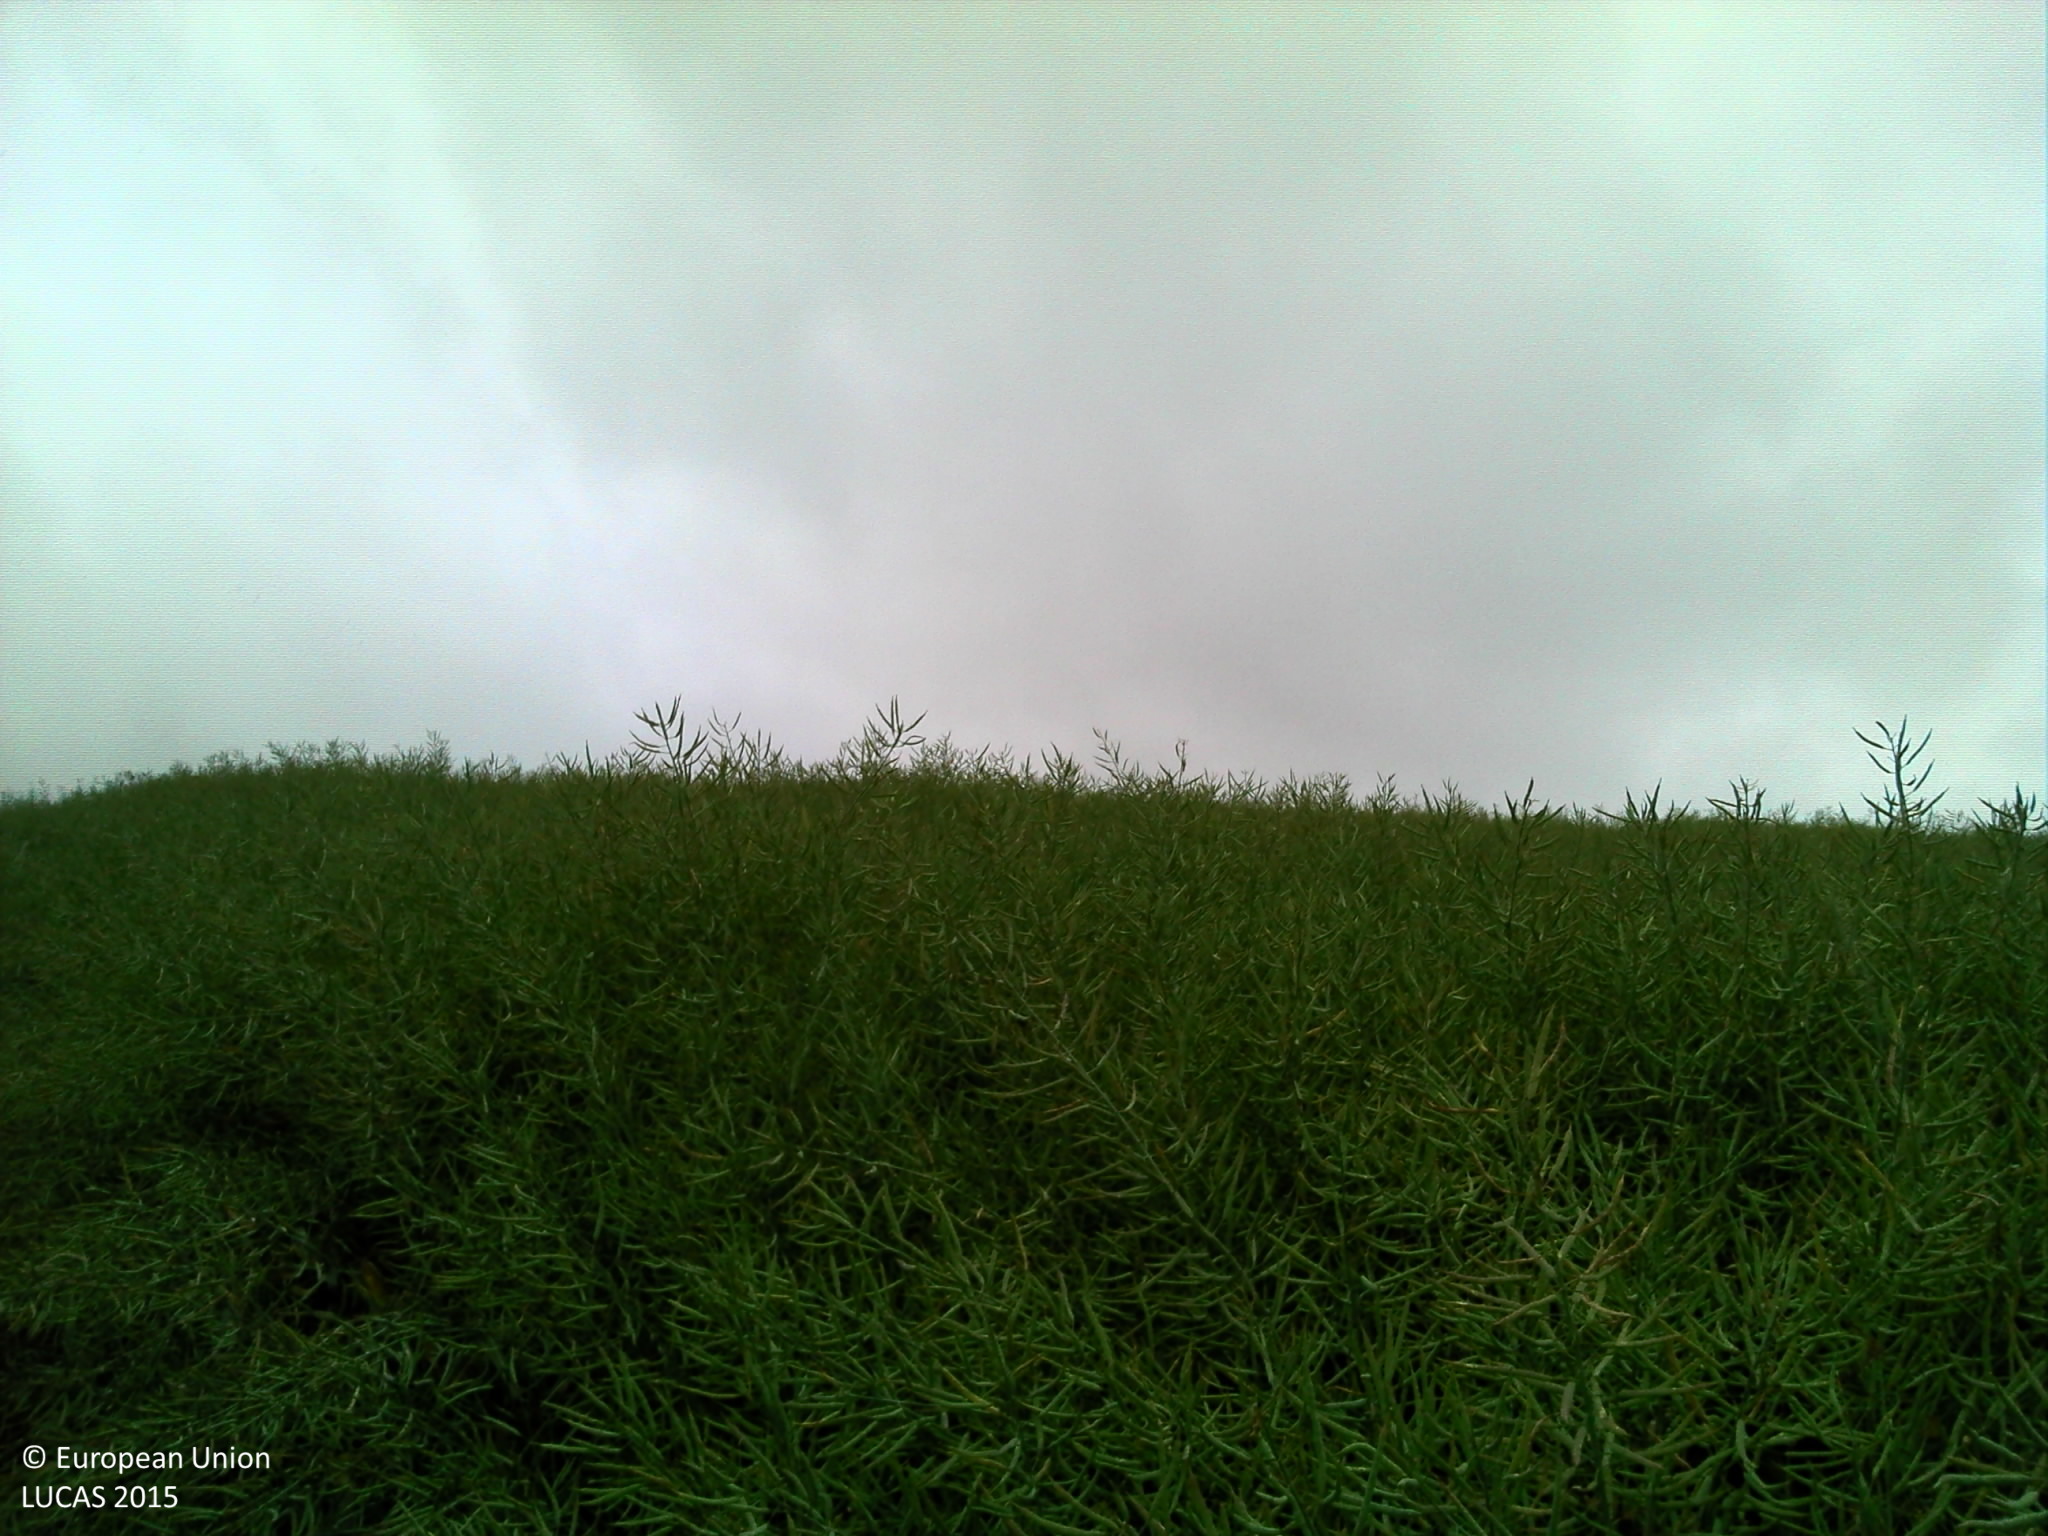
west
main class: Cropland
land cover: Rape and turnip rape
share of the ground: > 75 %
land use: Agriculture (excluding fallow land and kitchen gardens)
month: June
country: FR
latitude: 49.4795
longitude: 2.4101
